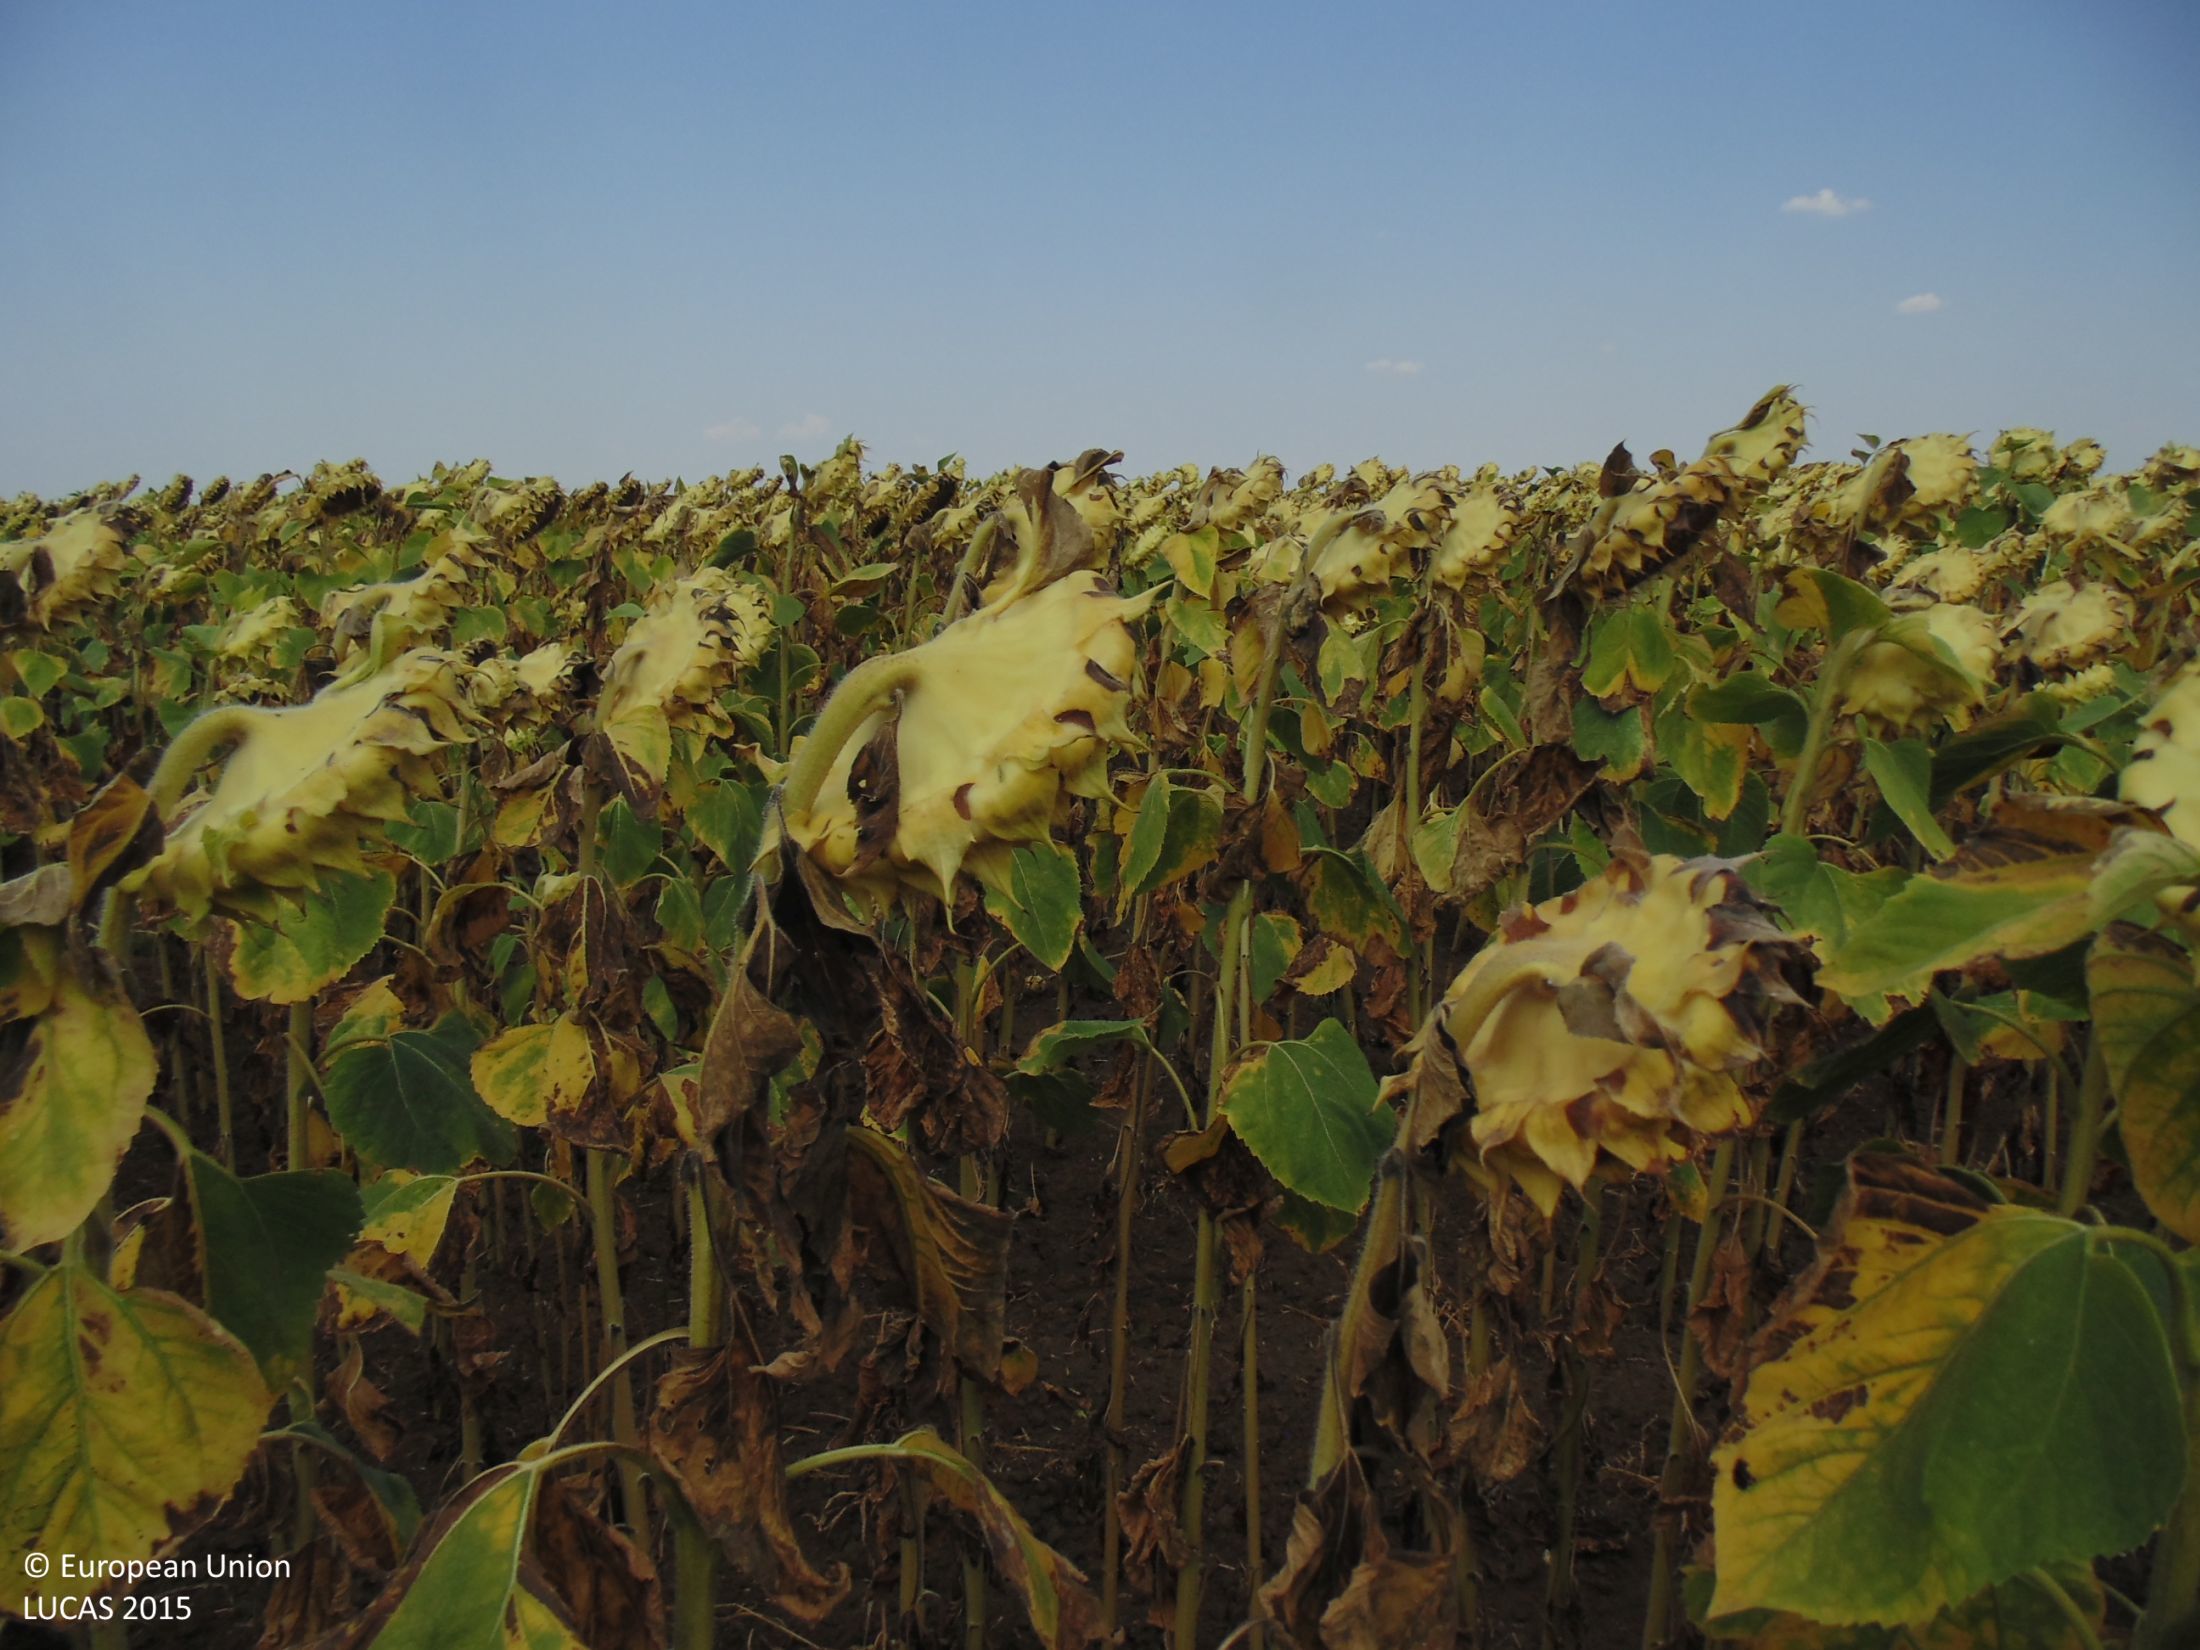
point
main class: Cropland
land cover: Sunflower
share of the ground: > 75 %
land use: Agriculture (excluding fallow land and kitchen gardens)
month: August
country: BG
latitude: 43.8596
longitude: 27.5168
